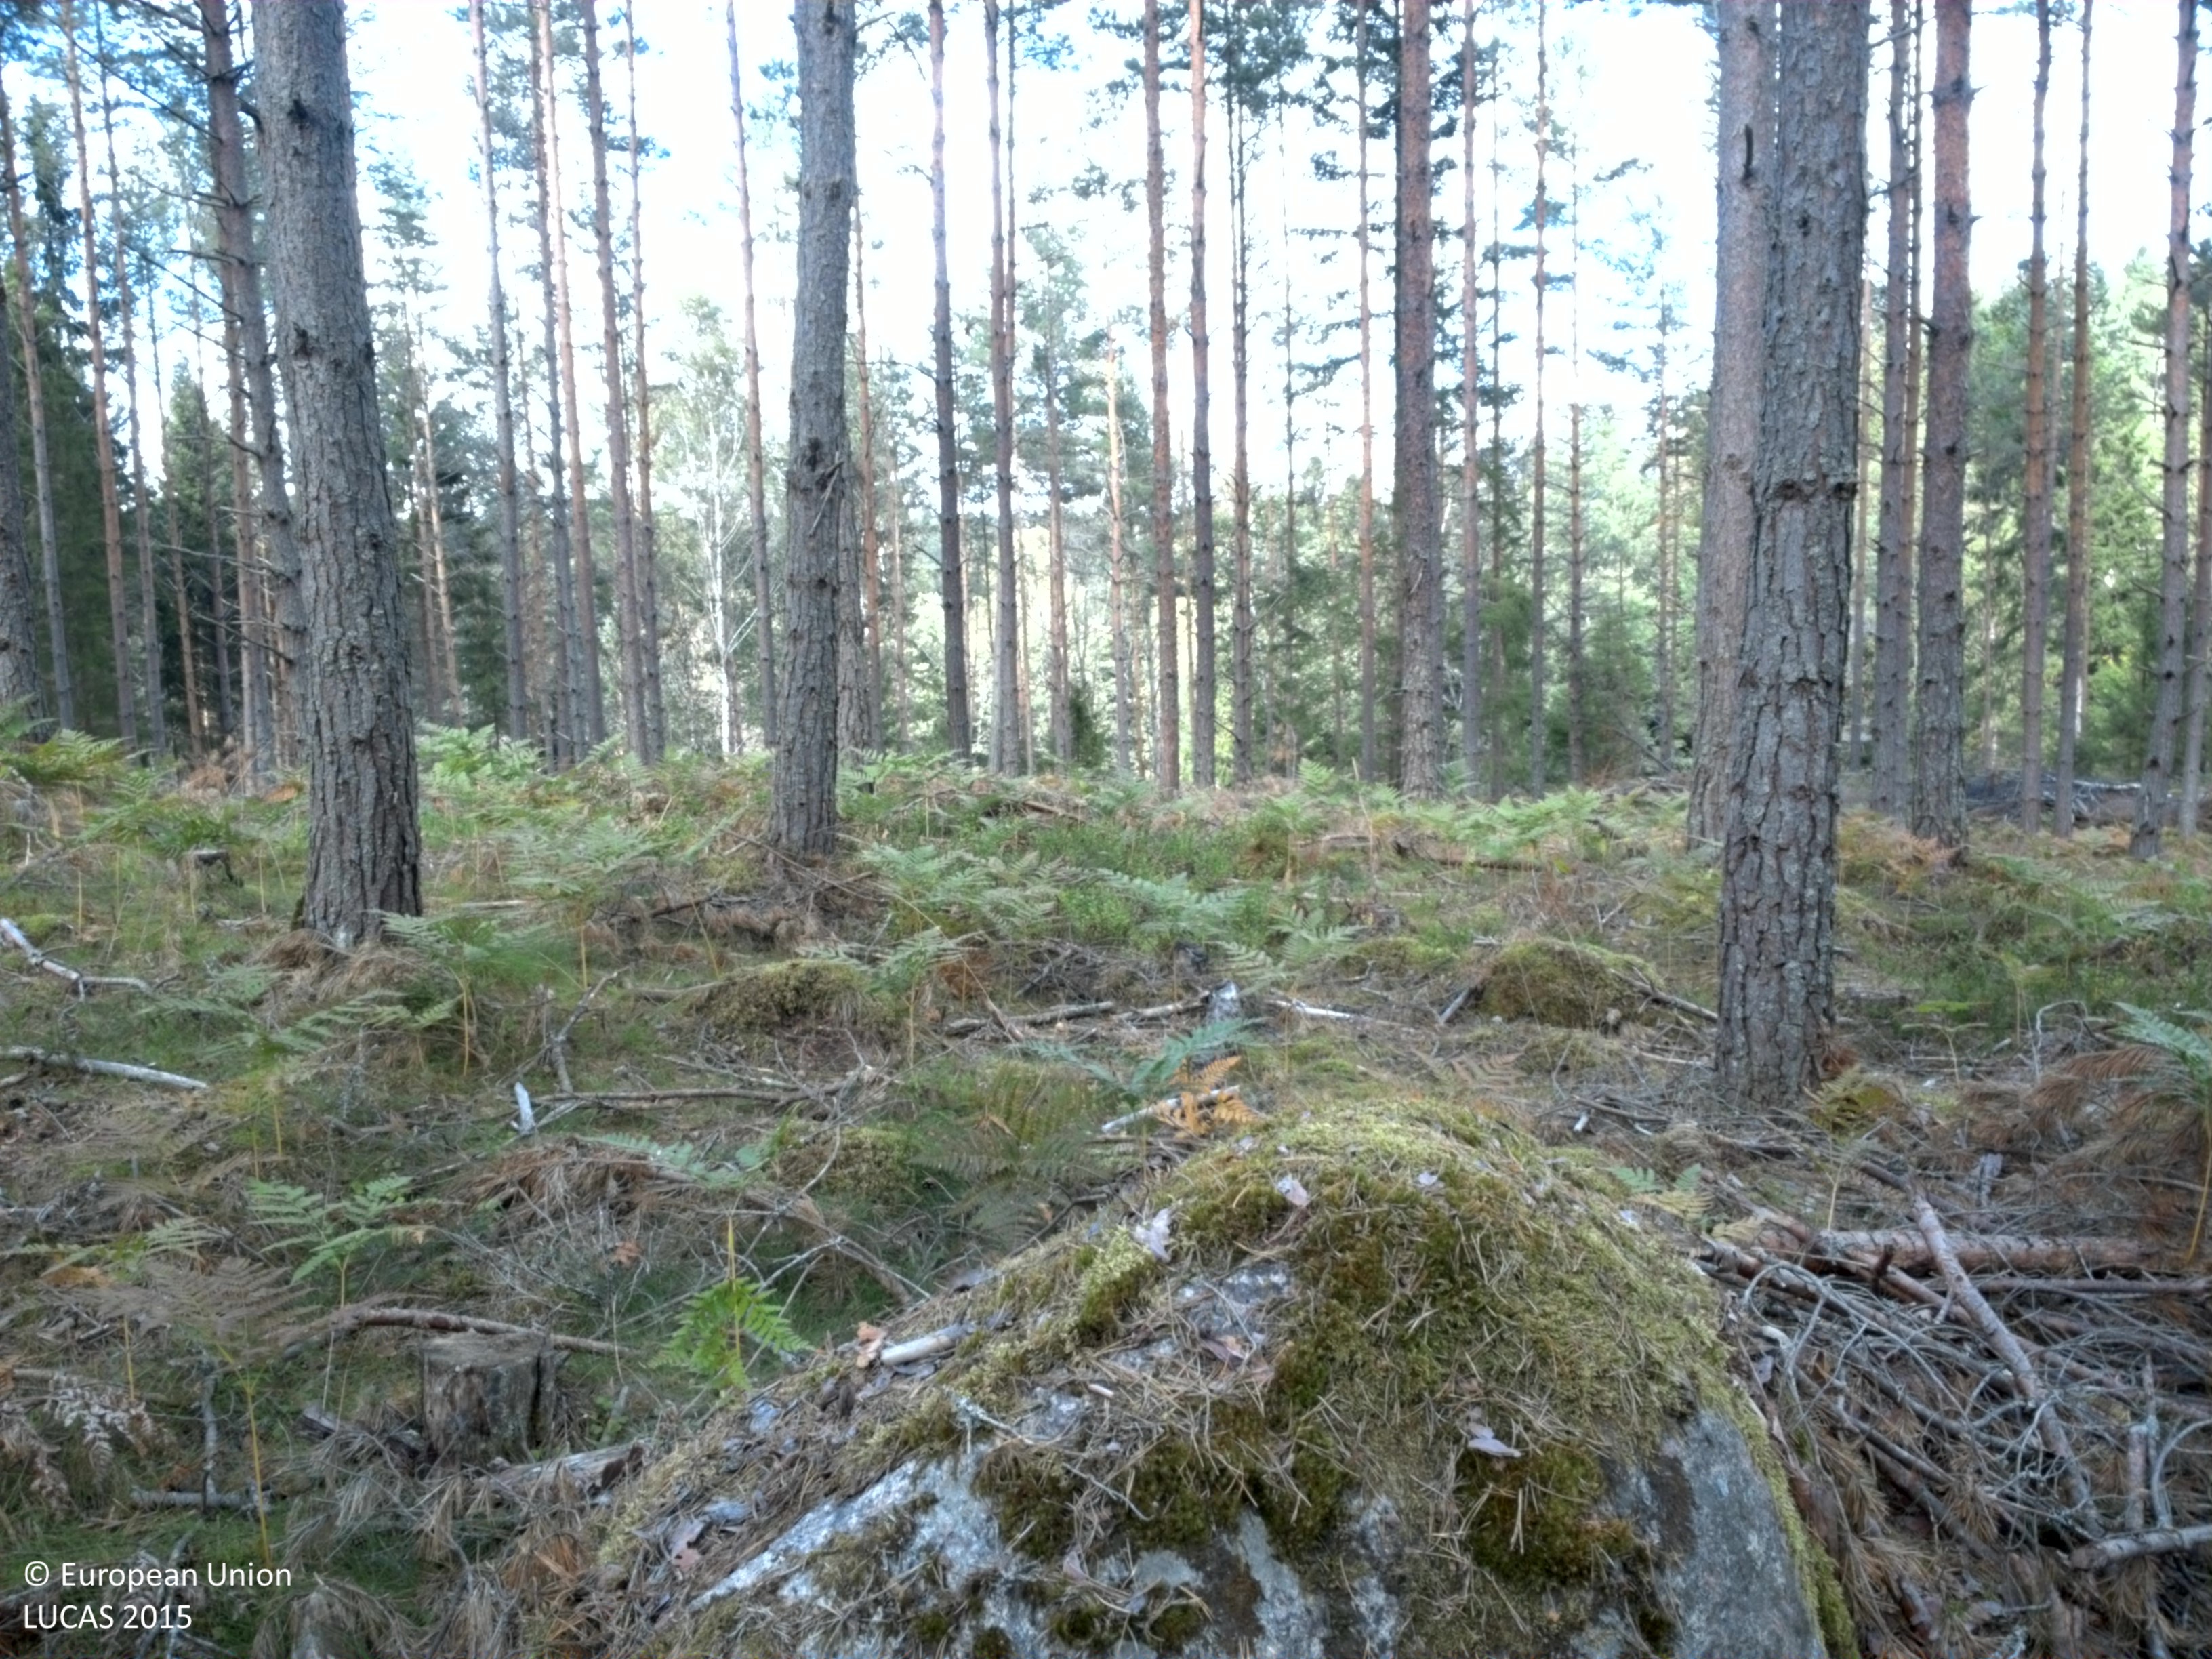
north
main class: Woodland
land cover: Pine dominated coniferous woodland
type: boreal forest
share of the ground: 50 - 75 %
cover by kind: coniferous forest trees 60 %, herbaceous plants 20 %, lichens and mosses 20 %
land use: Forestry
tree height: > 5 m
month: September
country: SE
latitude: 59.3625
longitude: 18.4981
